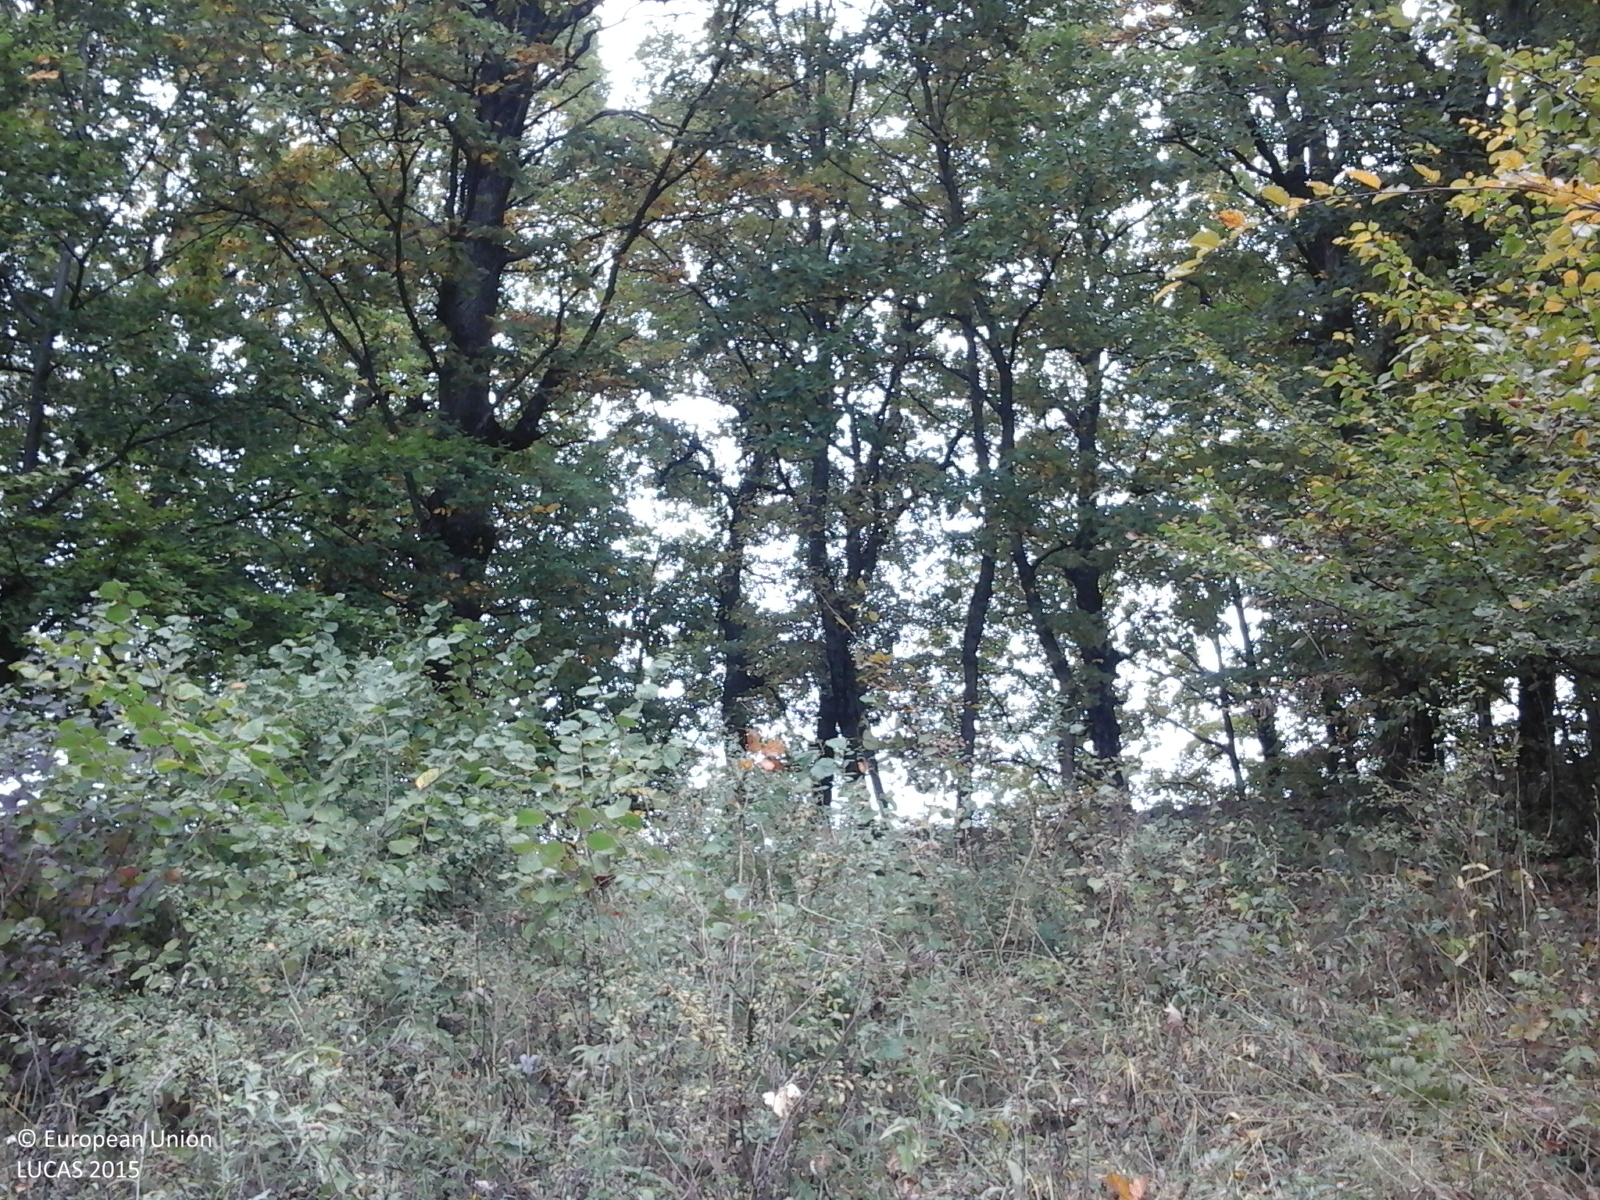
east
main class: Shrubland
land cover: Shrubland with sparse tree cover
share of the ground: > 75 %
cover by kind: shrubs 75 %, herbaceous plants 20 %, broadleaved forest trees 5 %
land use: Forestry
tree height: < 5 m
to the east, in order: Shrubland with sparse tree cover; Broadleaved woodland; Grassland without tree/shrub cover; Tracks; Grassland without tree/shrub cover; Spontaneously vegetated surfaces
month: October
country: RO
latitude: 46.7952
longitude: 24.9419
